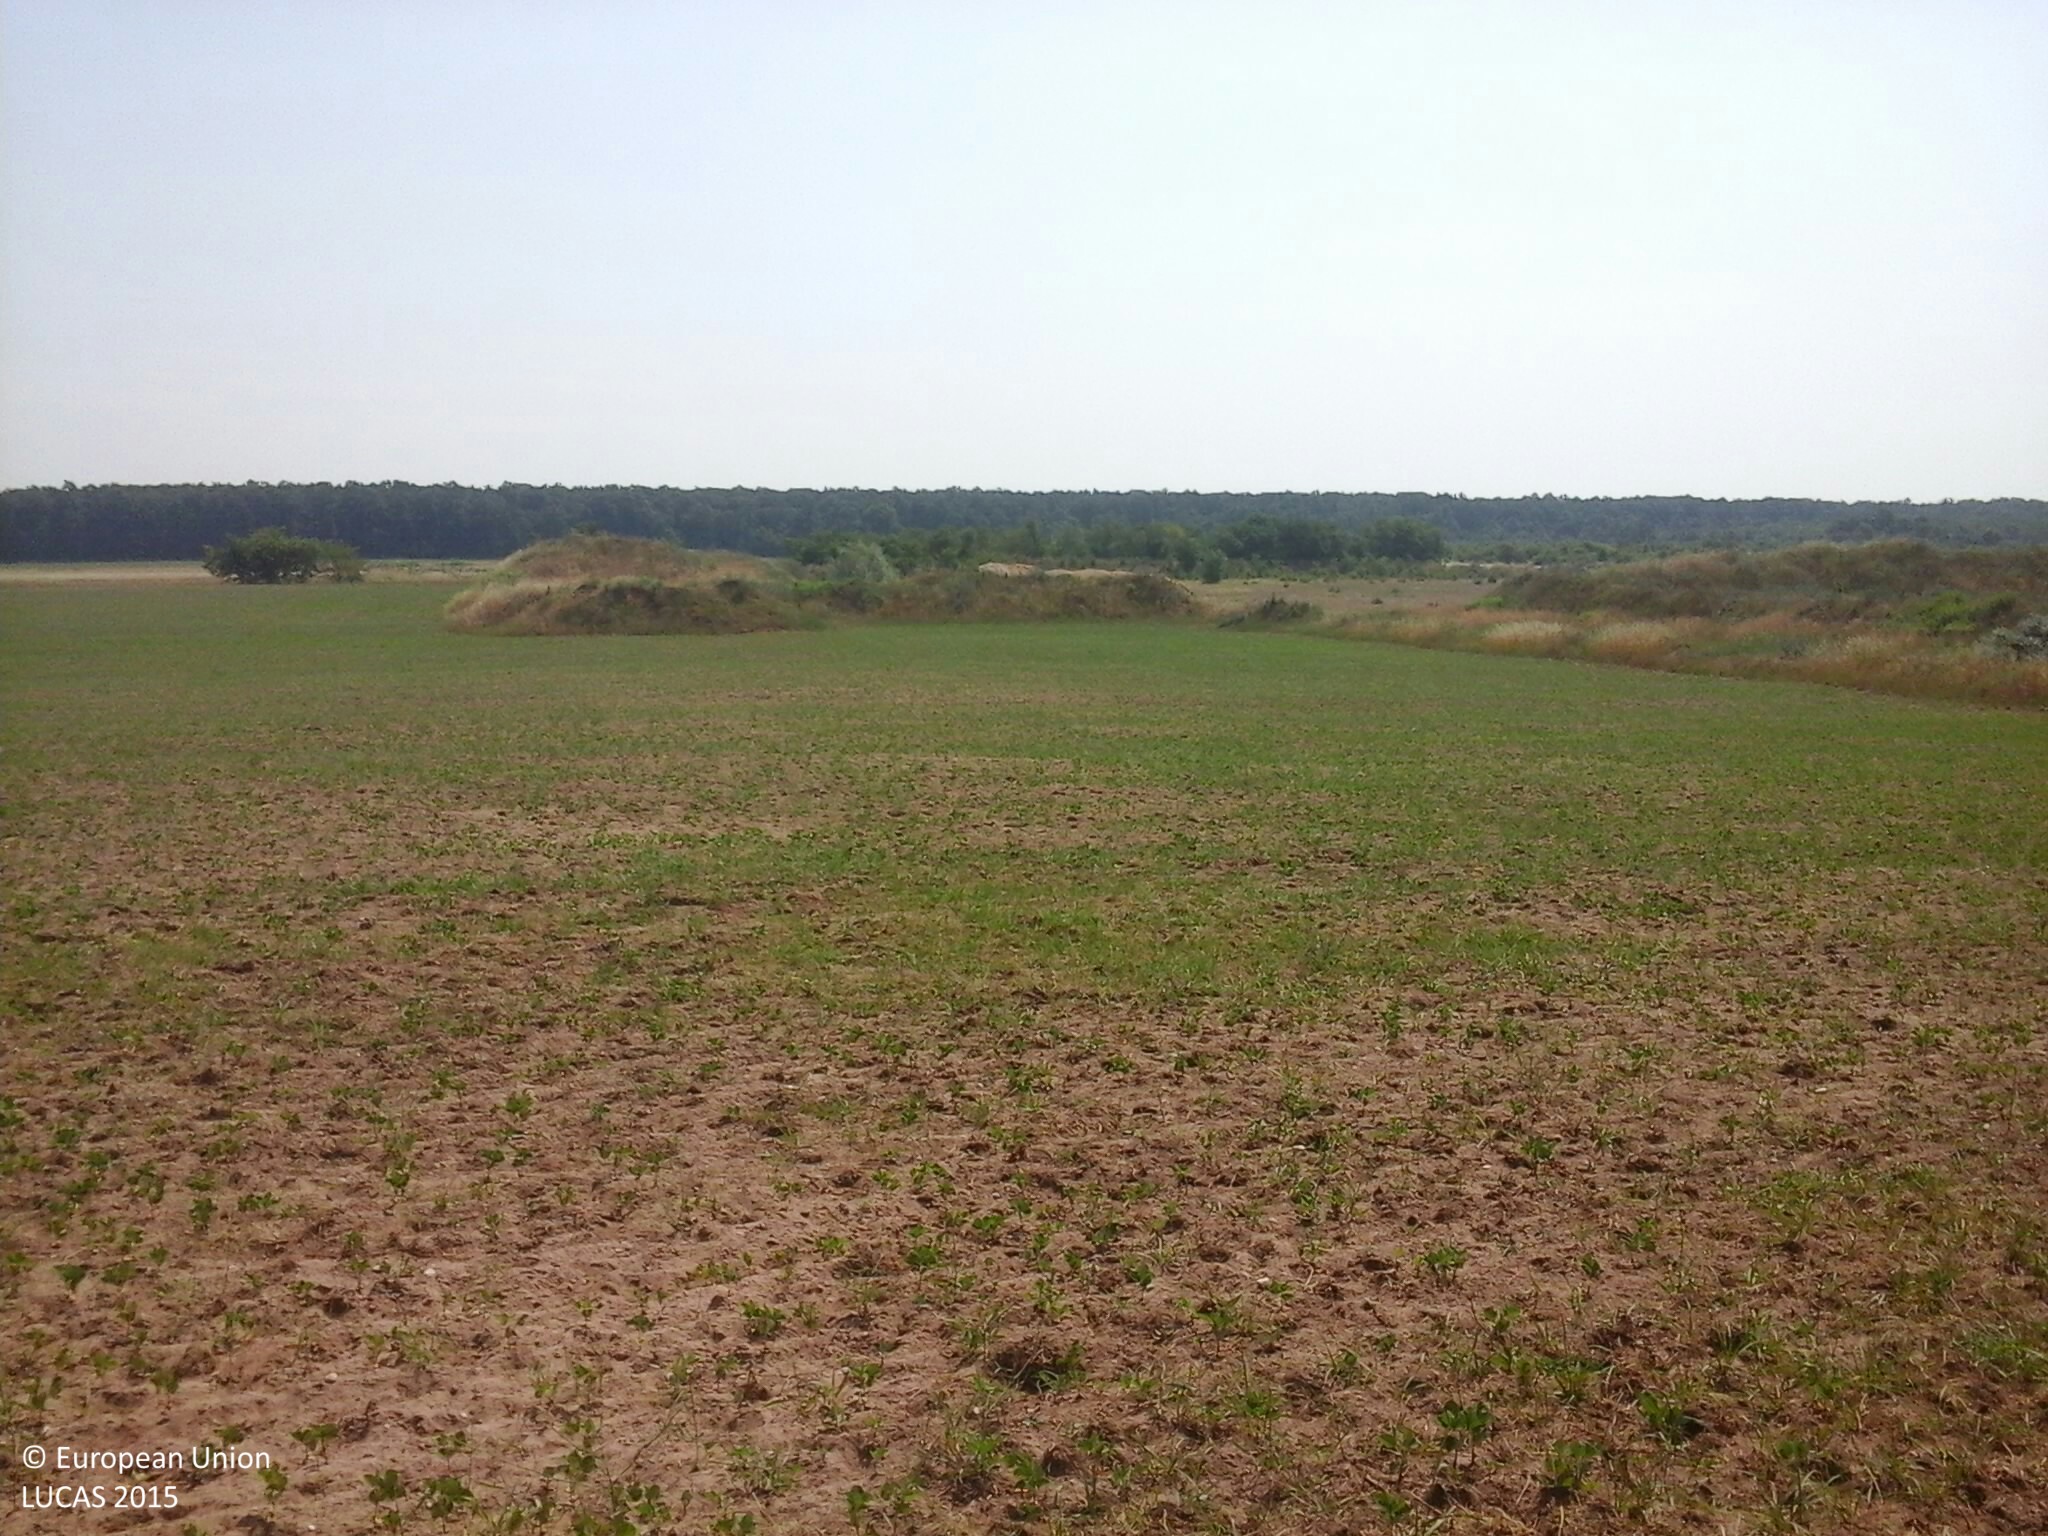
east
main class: Cropland
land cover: Soya
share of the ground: 10 - 25 %
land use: Agriculture (excluding fallow land and kitchen gardens)
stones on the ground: < 10 %
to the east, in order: Soya; Spontaneously vegetated surfaces
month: July
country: HU
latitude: 47.0481
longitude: 17.4699
